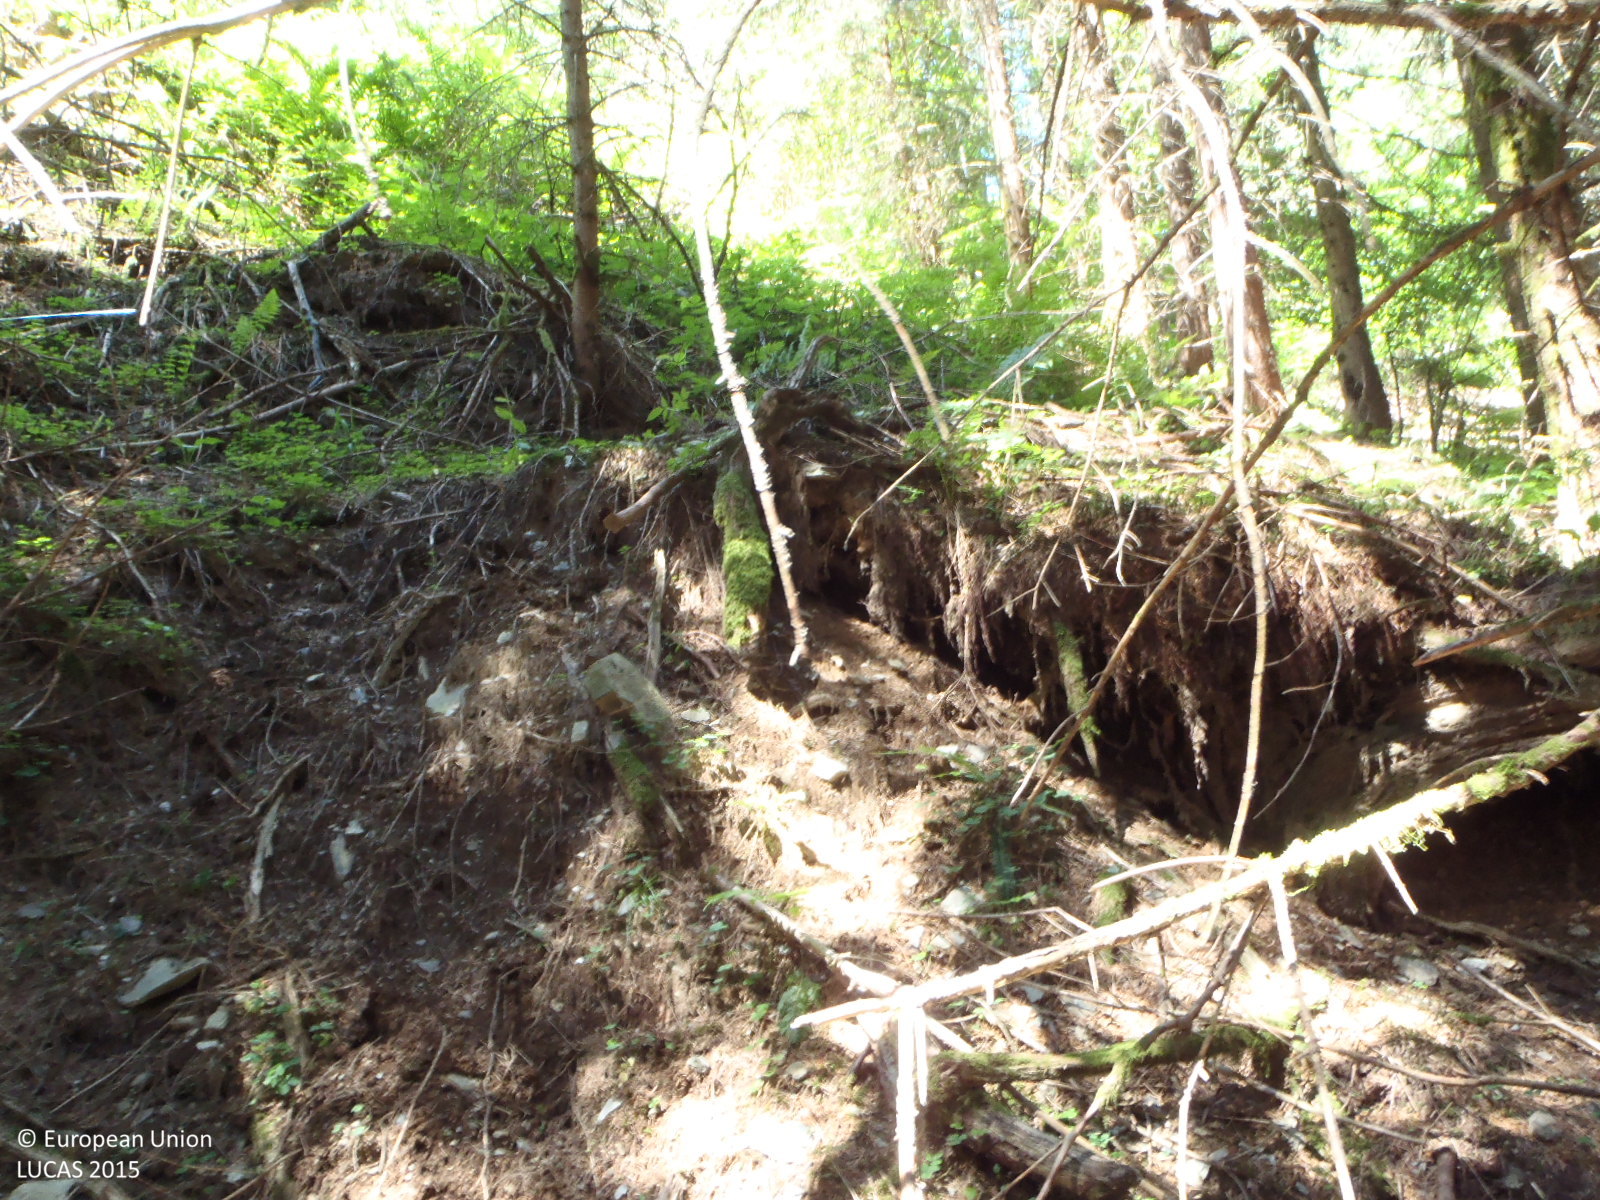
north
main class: Woodland
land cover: Spruce dominated coniferous woodland
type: alpine coniferous forest
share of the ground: > 75 %
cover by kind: coniferous forest trees 95 %, lichens and mosses 5 %
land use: Forestry
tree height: > 5 m
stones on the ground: < 10 %
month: July
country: AT
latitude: 47.3873
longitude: 12.3959
